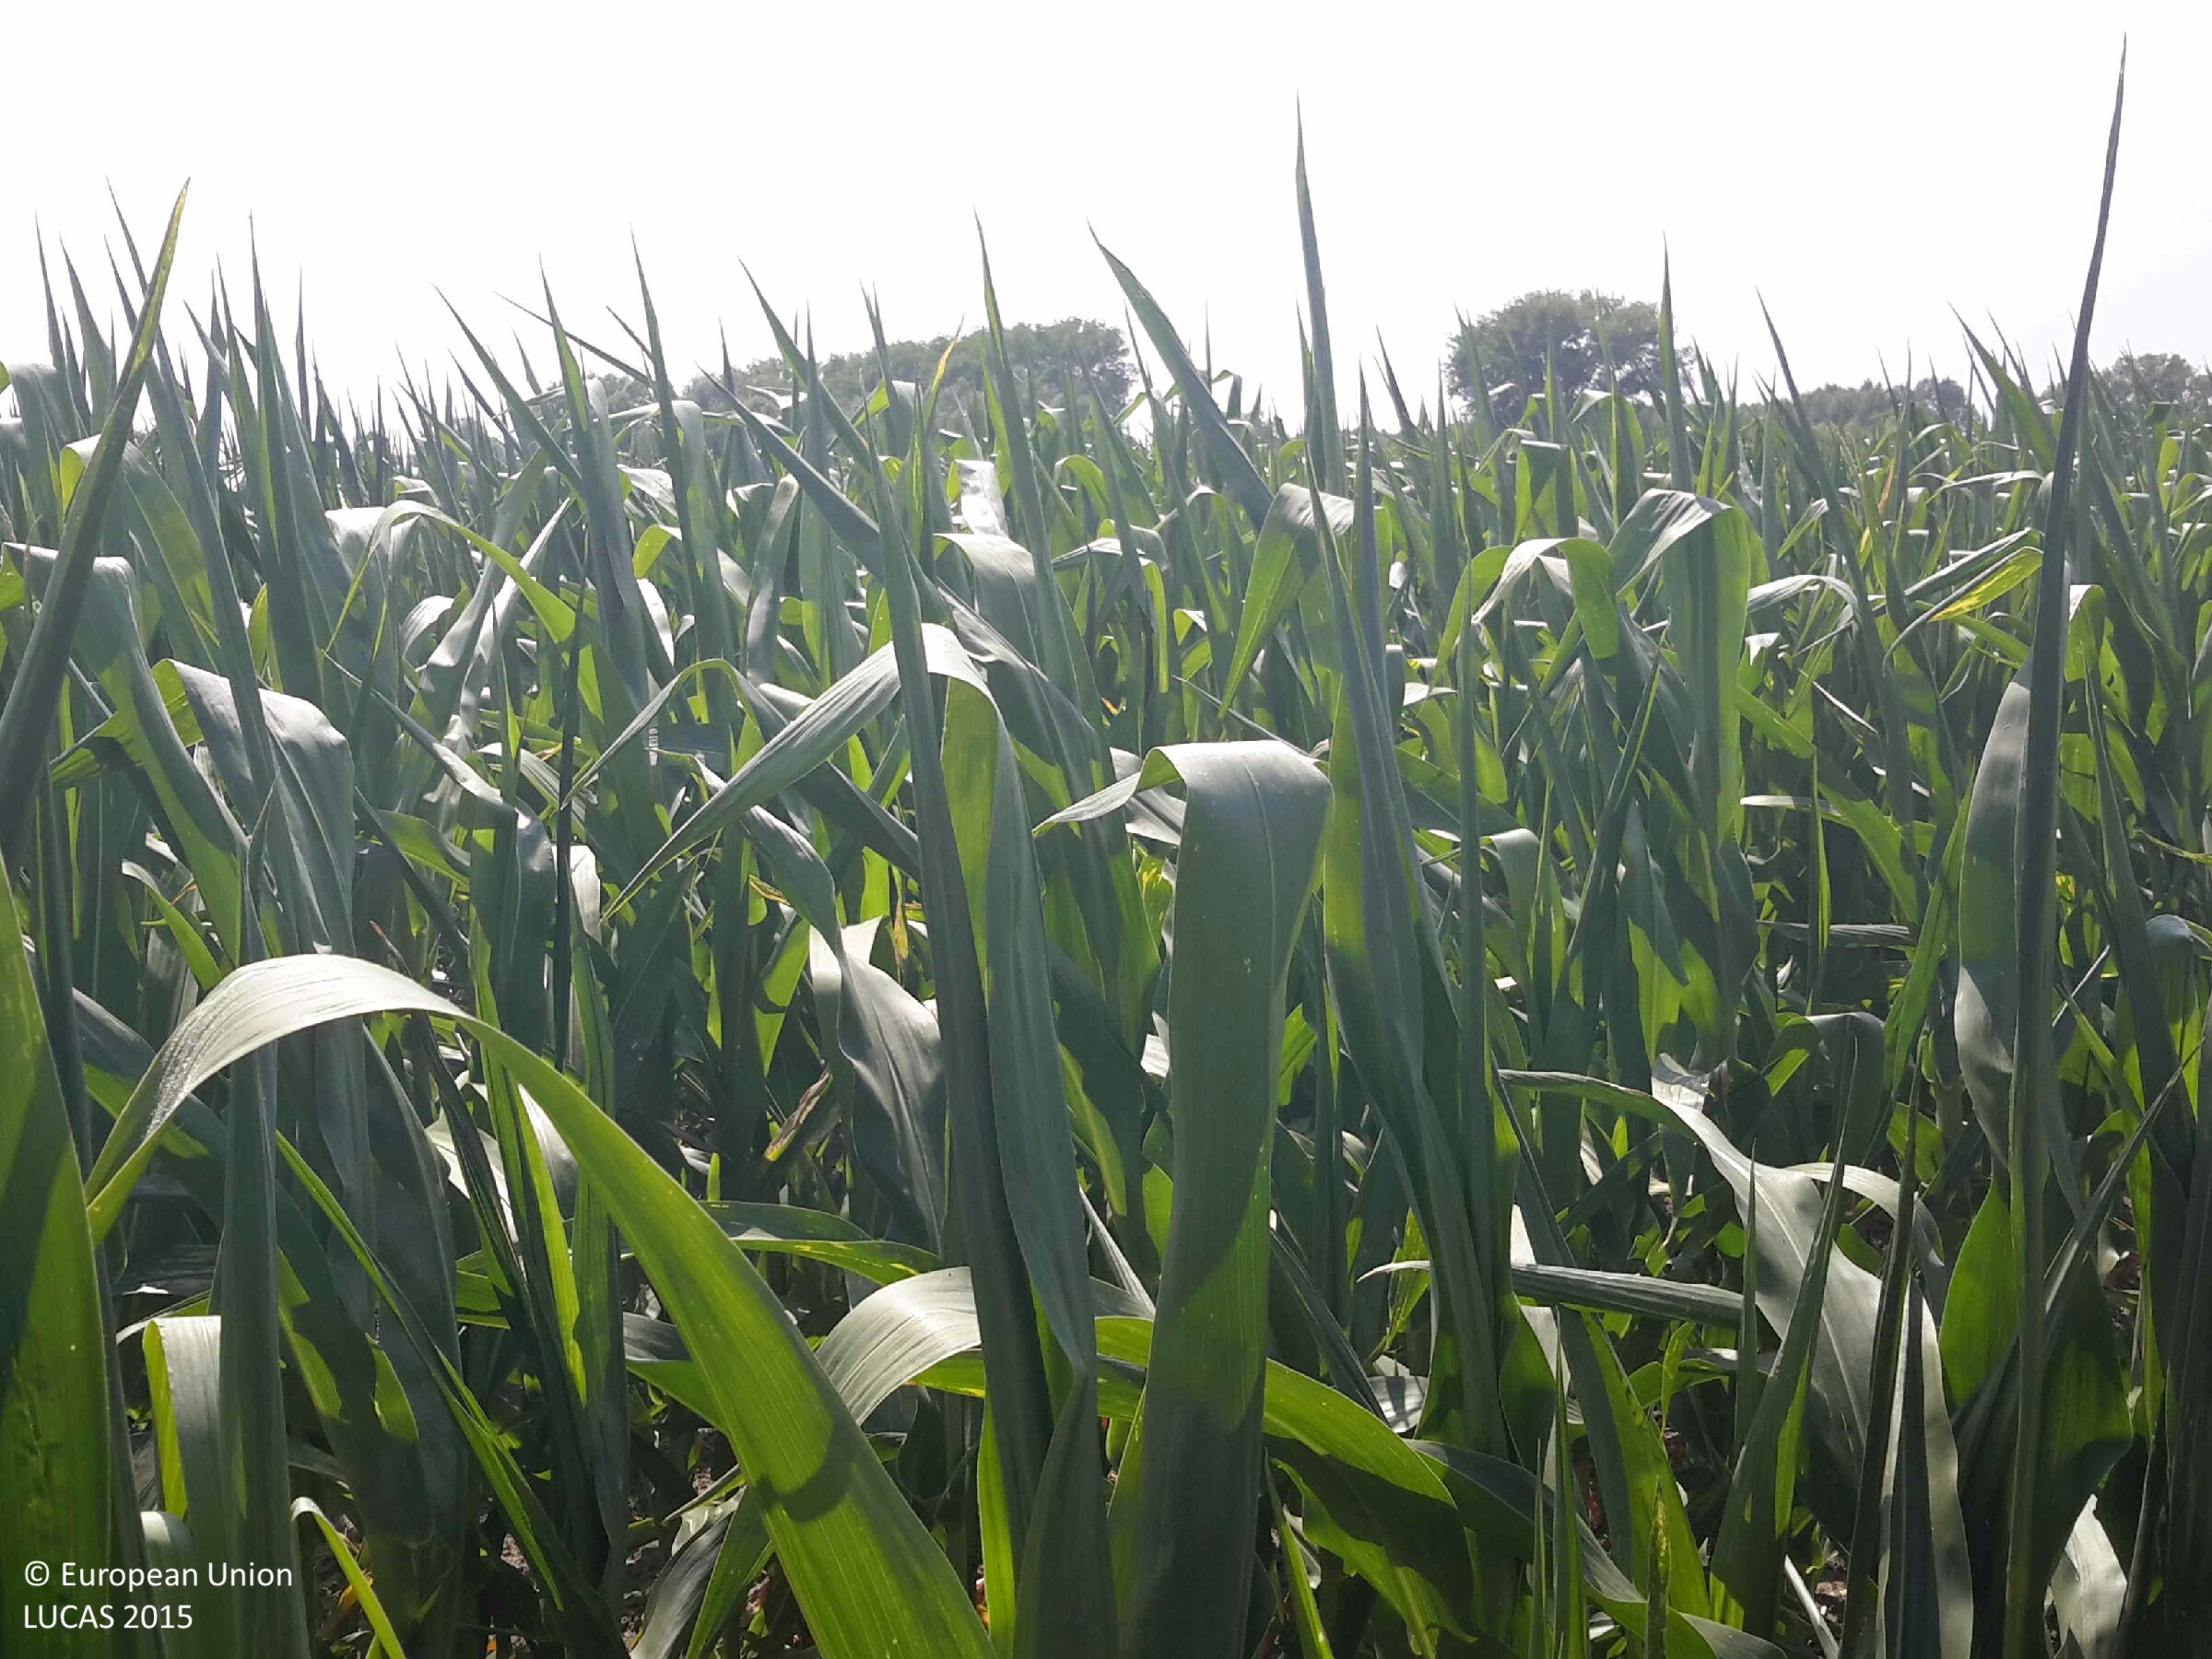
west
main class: Cropland
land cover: Maize
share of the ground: > 75 %
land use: Agriculture (excluding fallow land and kitchen gardens)
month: July
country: HU
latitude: 47.2826
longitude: 17.2114
